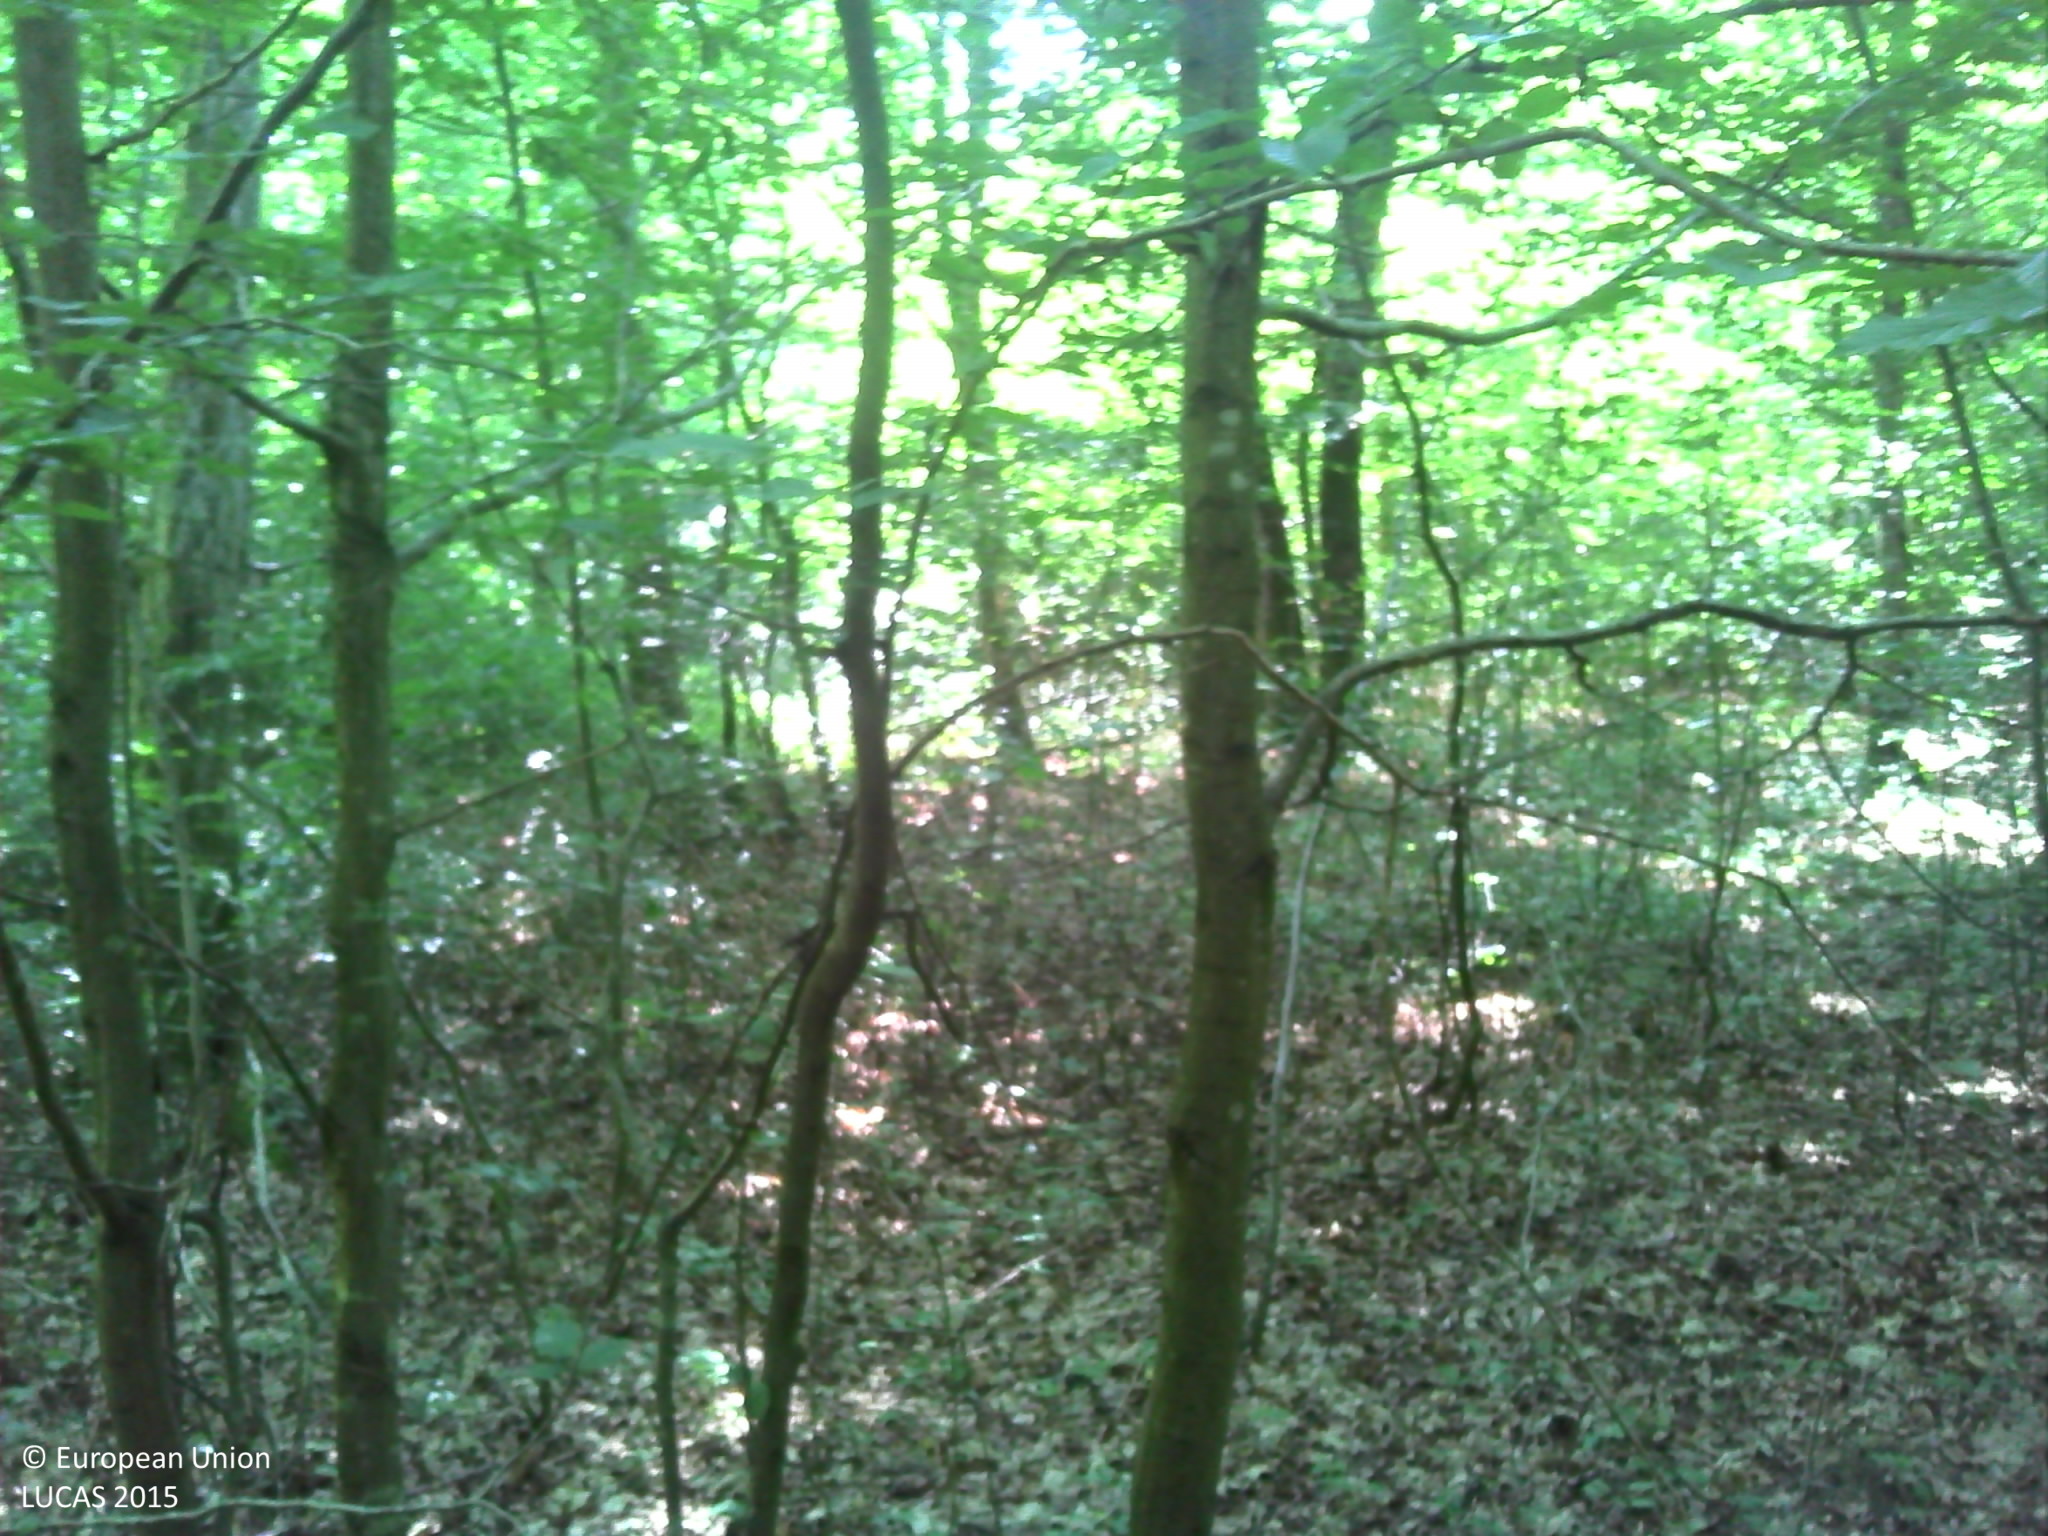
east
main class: Woodland
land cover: Broadleaved woodland
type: mesophytic deciduous forest
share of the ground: > 75 %
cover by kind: broadleaved forest trees 80 %, herbaceous plants 10 %, consolidated bare surface 10 %
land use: Forestry
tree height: > 5 m
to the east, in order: Broadleaved woodland
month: July
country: FR
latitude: 48.9682
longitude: 1.1139
